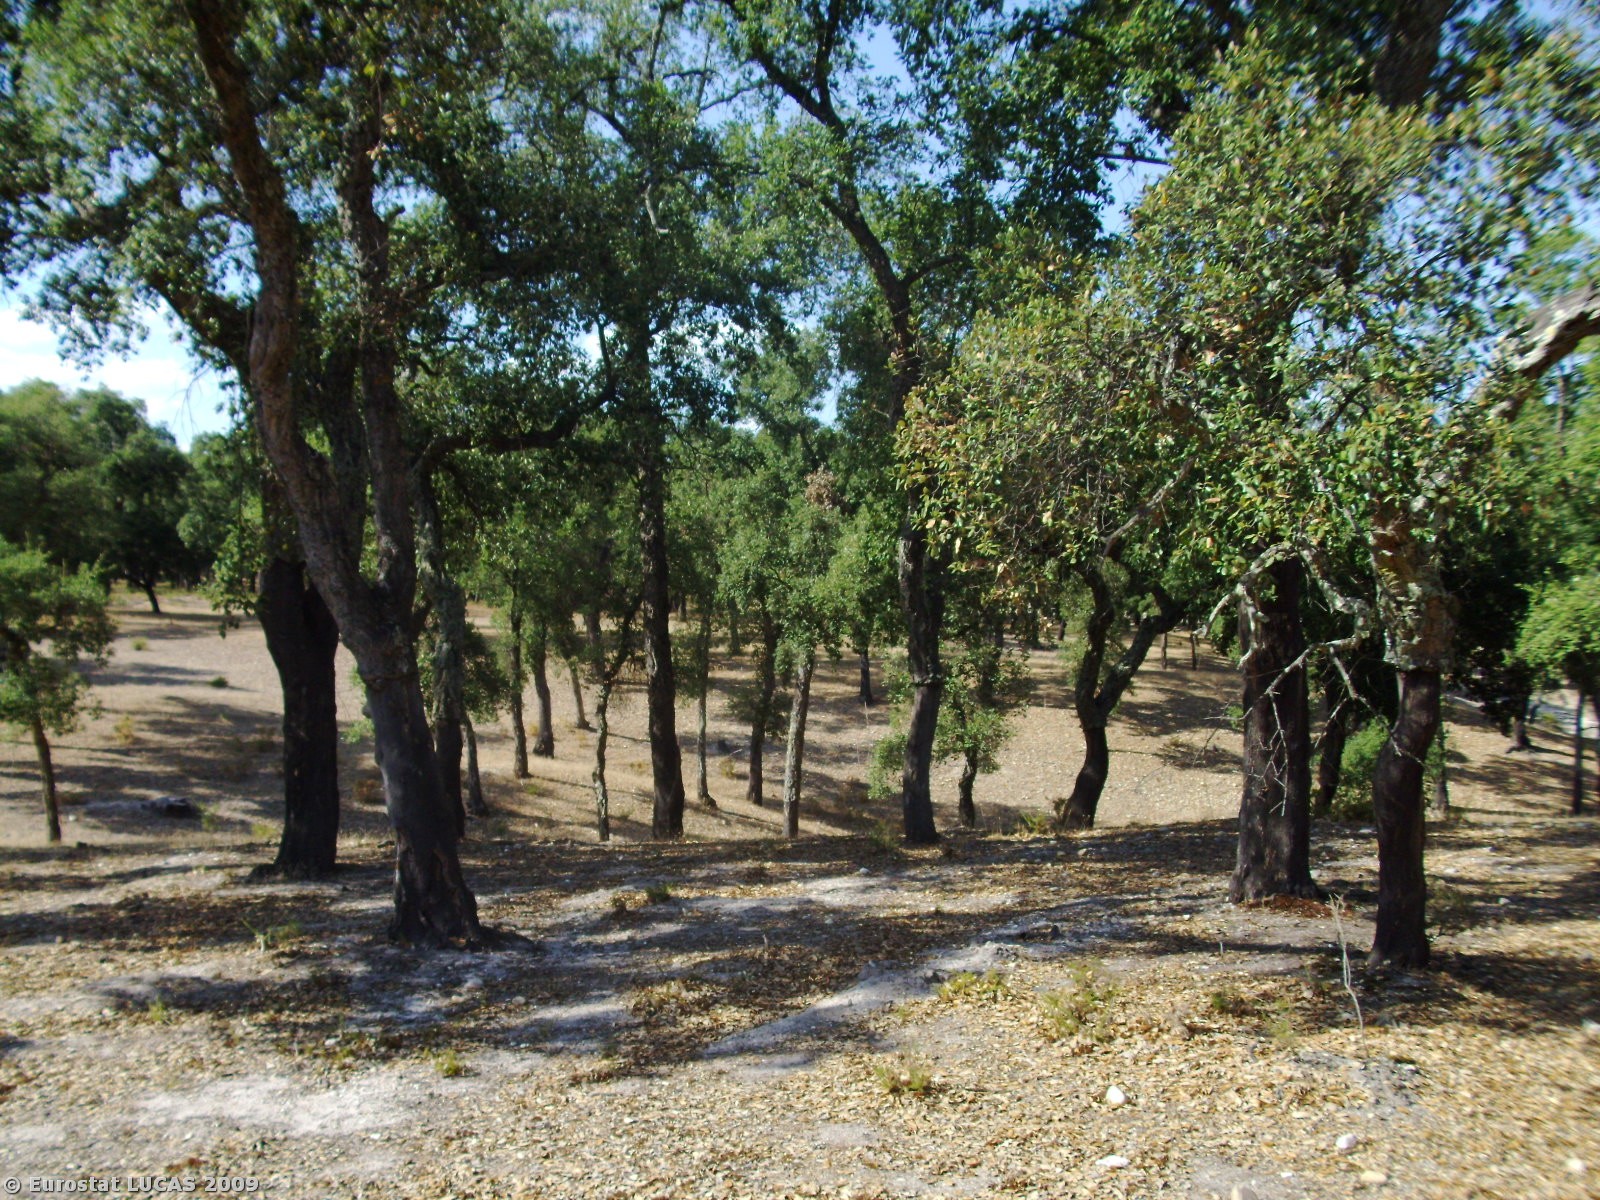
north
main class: Woodland
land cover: Broadleaved woodland
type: broadleaved evergreen forest
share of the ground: > 75 %
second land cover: Spontaneously vegetated surfaces
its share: 10 - 25 %
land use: Forestry
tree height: > 5 m
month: August
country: PT
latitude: 39.3218
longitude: -8.0240
